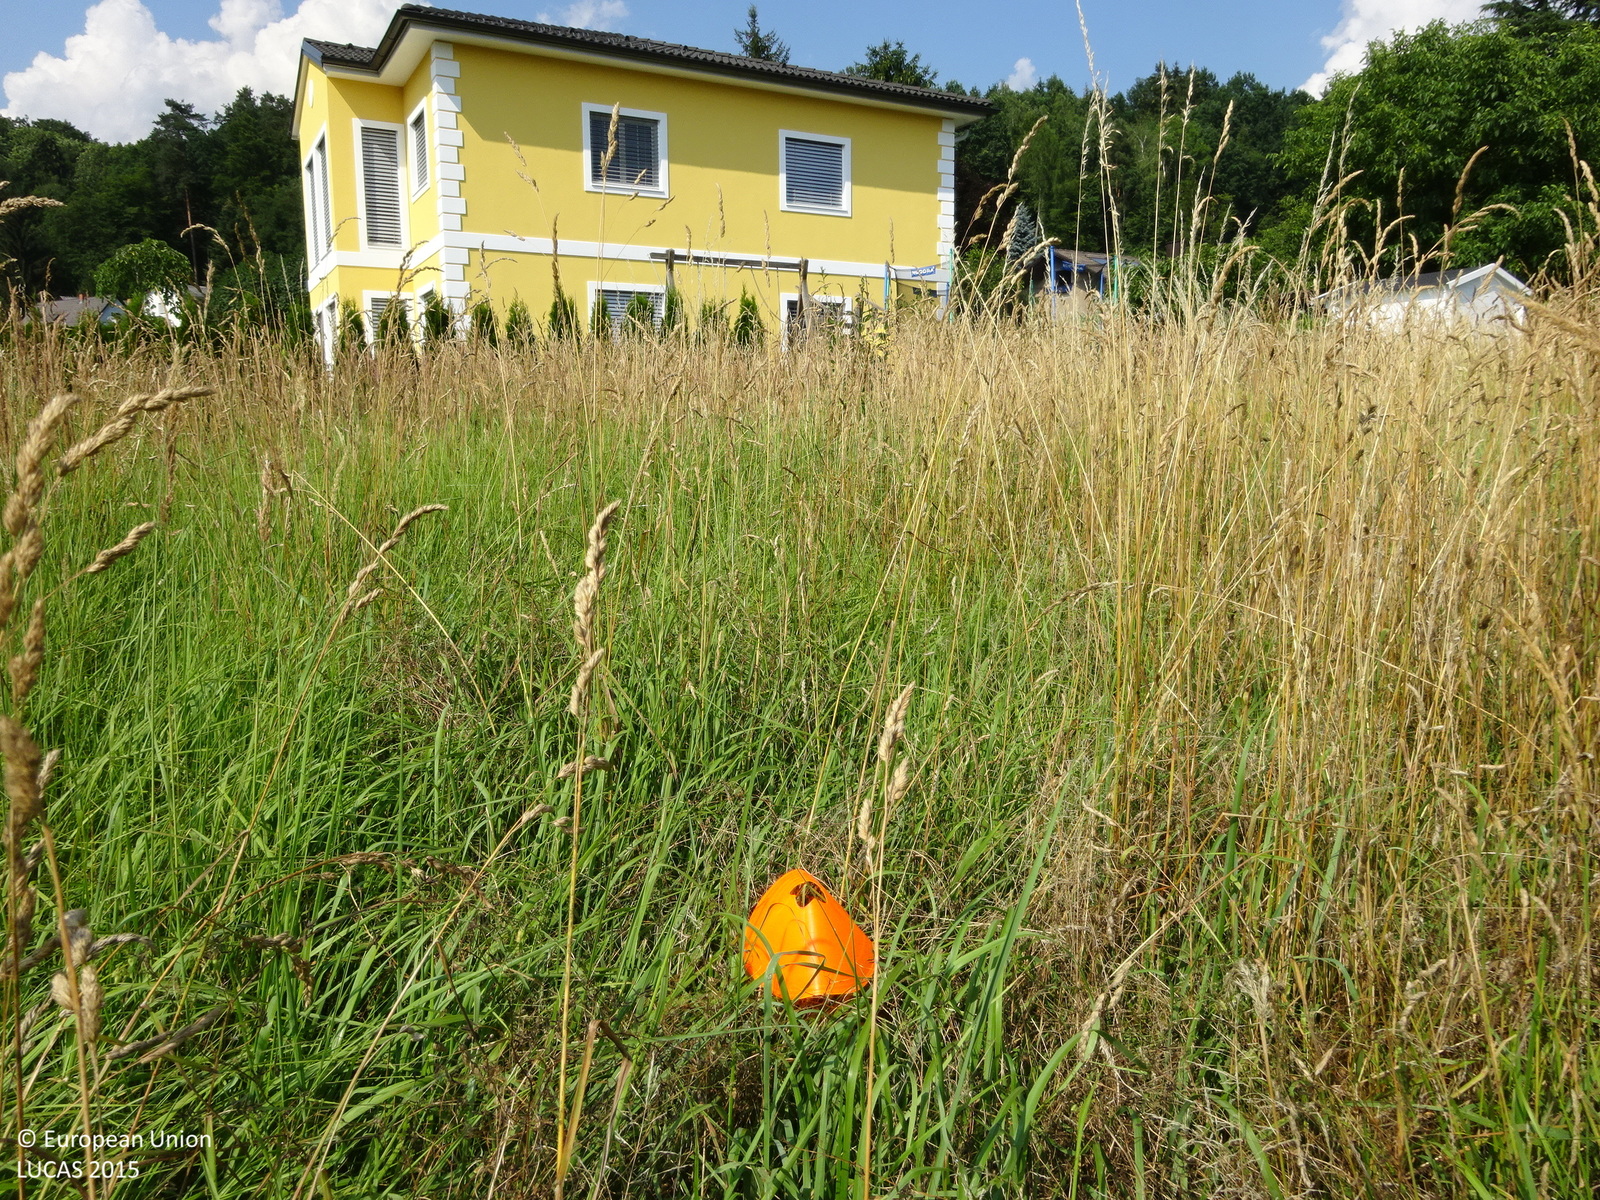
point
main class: Grassland
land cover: Grassland without tree/shrub cover
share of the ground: > 75 %
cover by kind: herbaceous plants 100 %
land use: Agriculture (excluding fallow land and kitchen gardens)
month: July
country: AT
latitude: 47.1382
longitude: 15.3398
